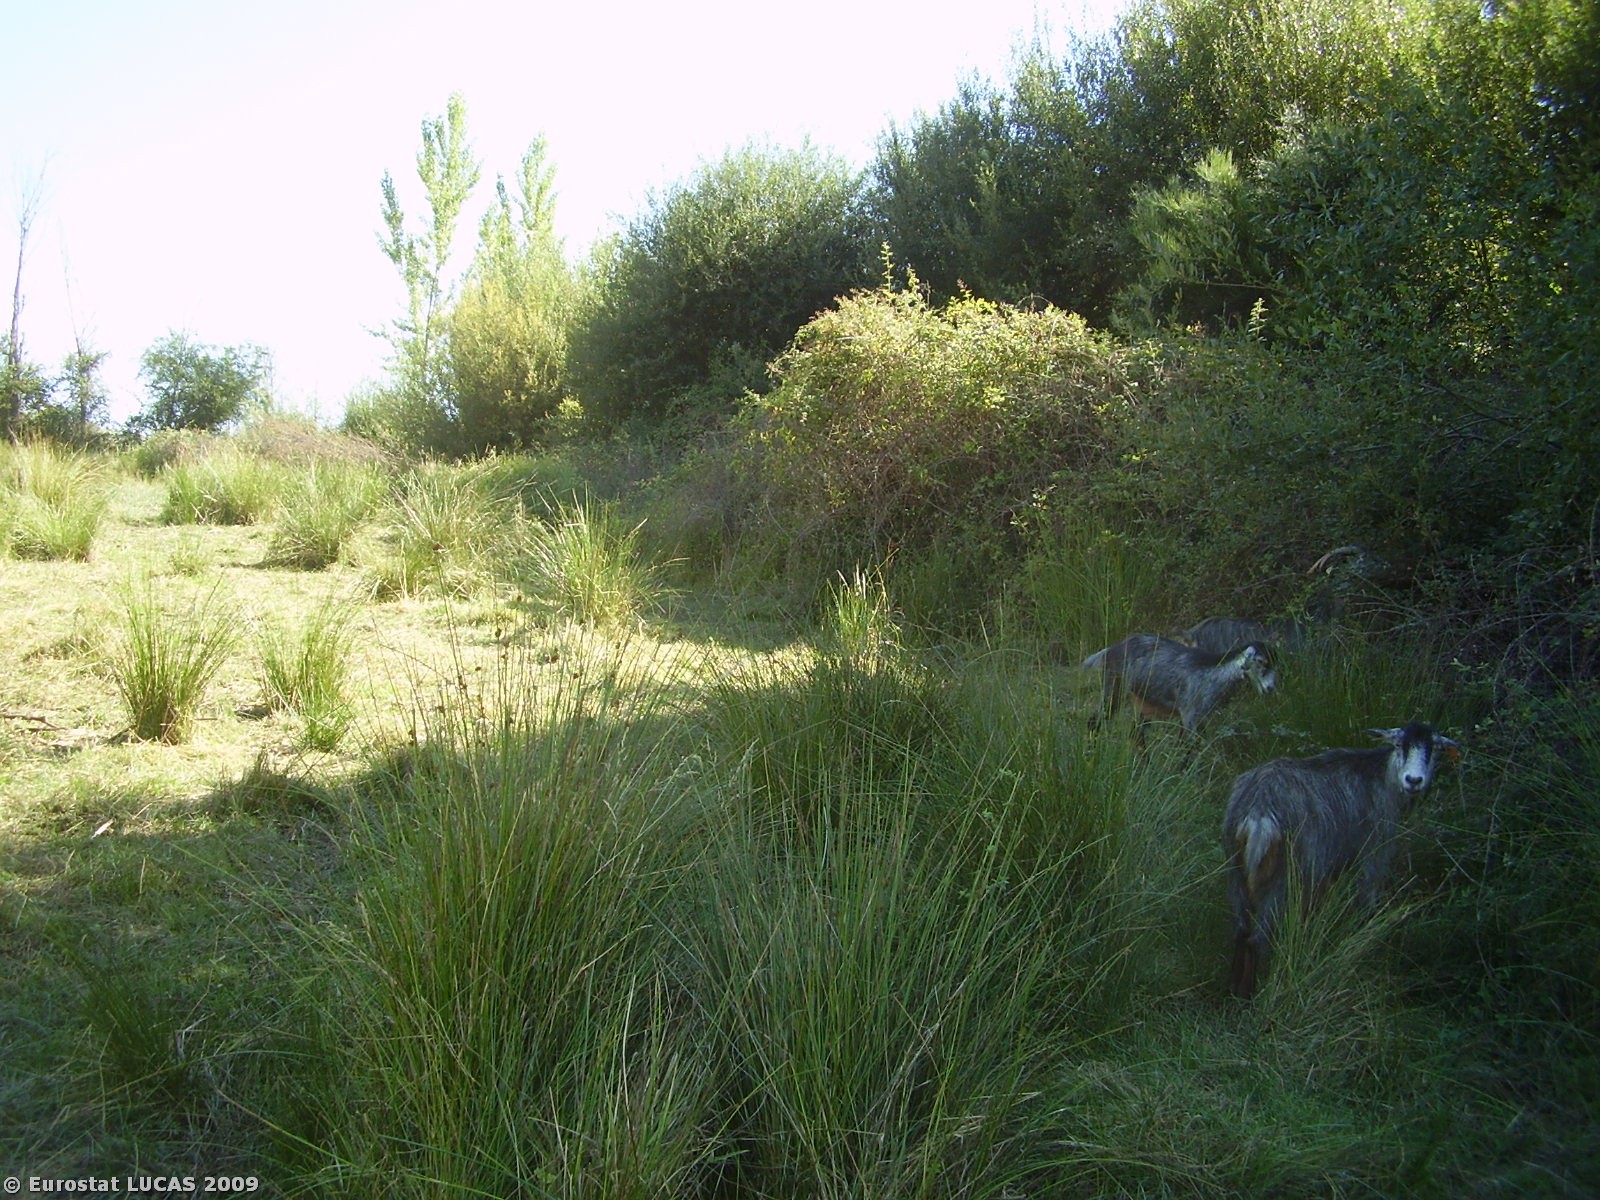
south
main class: Grassland
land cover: Spontaneously vegetated surfaces
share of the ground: > 75 %
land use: Fallow land
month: August
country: PT
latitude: 41.2784
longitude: -6.7846
